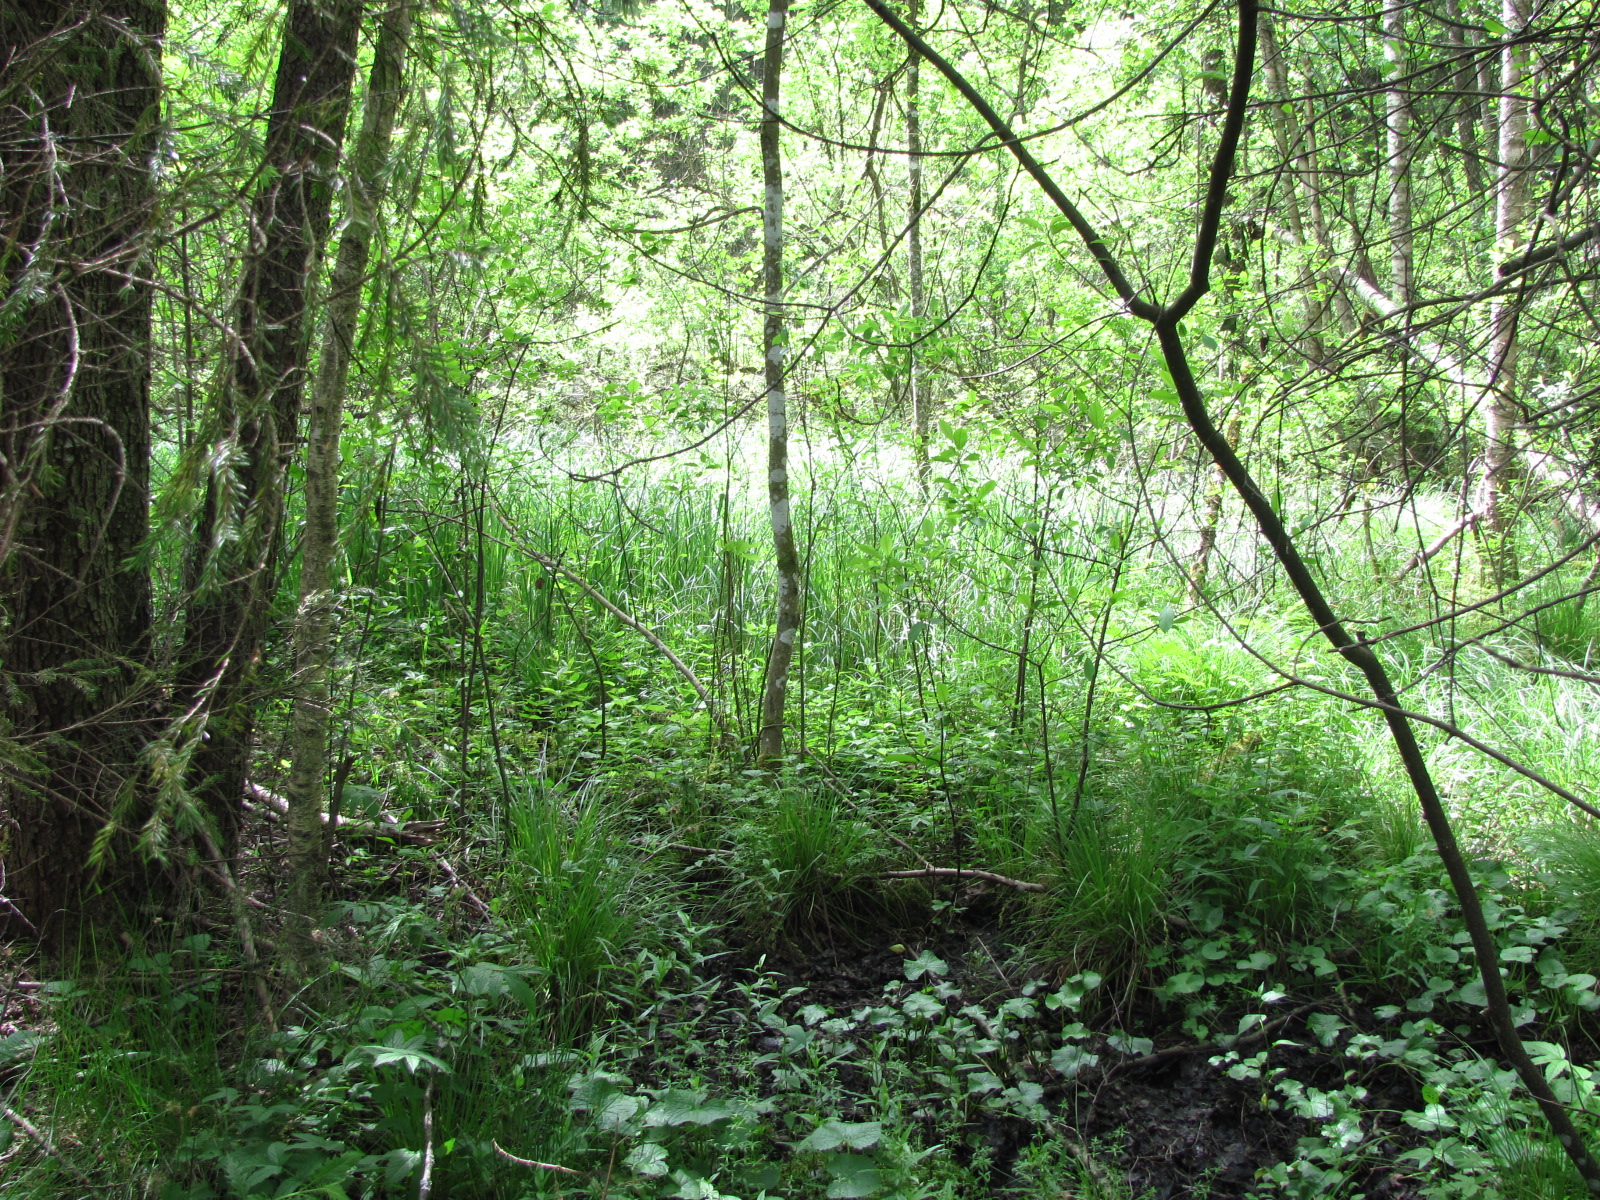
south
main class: Woodland
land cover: Spruce dominated mixed woodland
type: hemiboreal forest and nemoral coniferous forest and mixed broadleaved-coniferous forest
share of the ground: > 75 %
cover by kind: broadleaved forest trees 60 %, coniferous forest trees 40 %
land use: Forestry
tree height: > 5 m
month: June
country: LV
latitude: 56.6547
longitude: 23.8651
